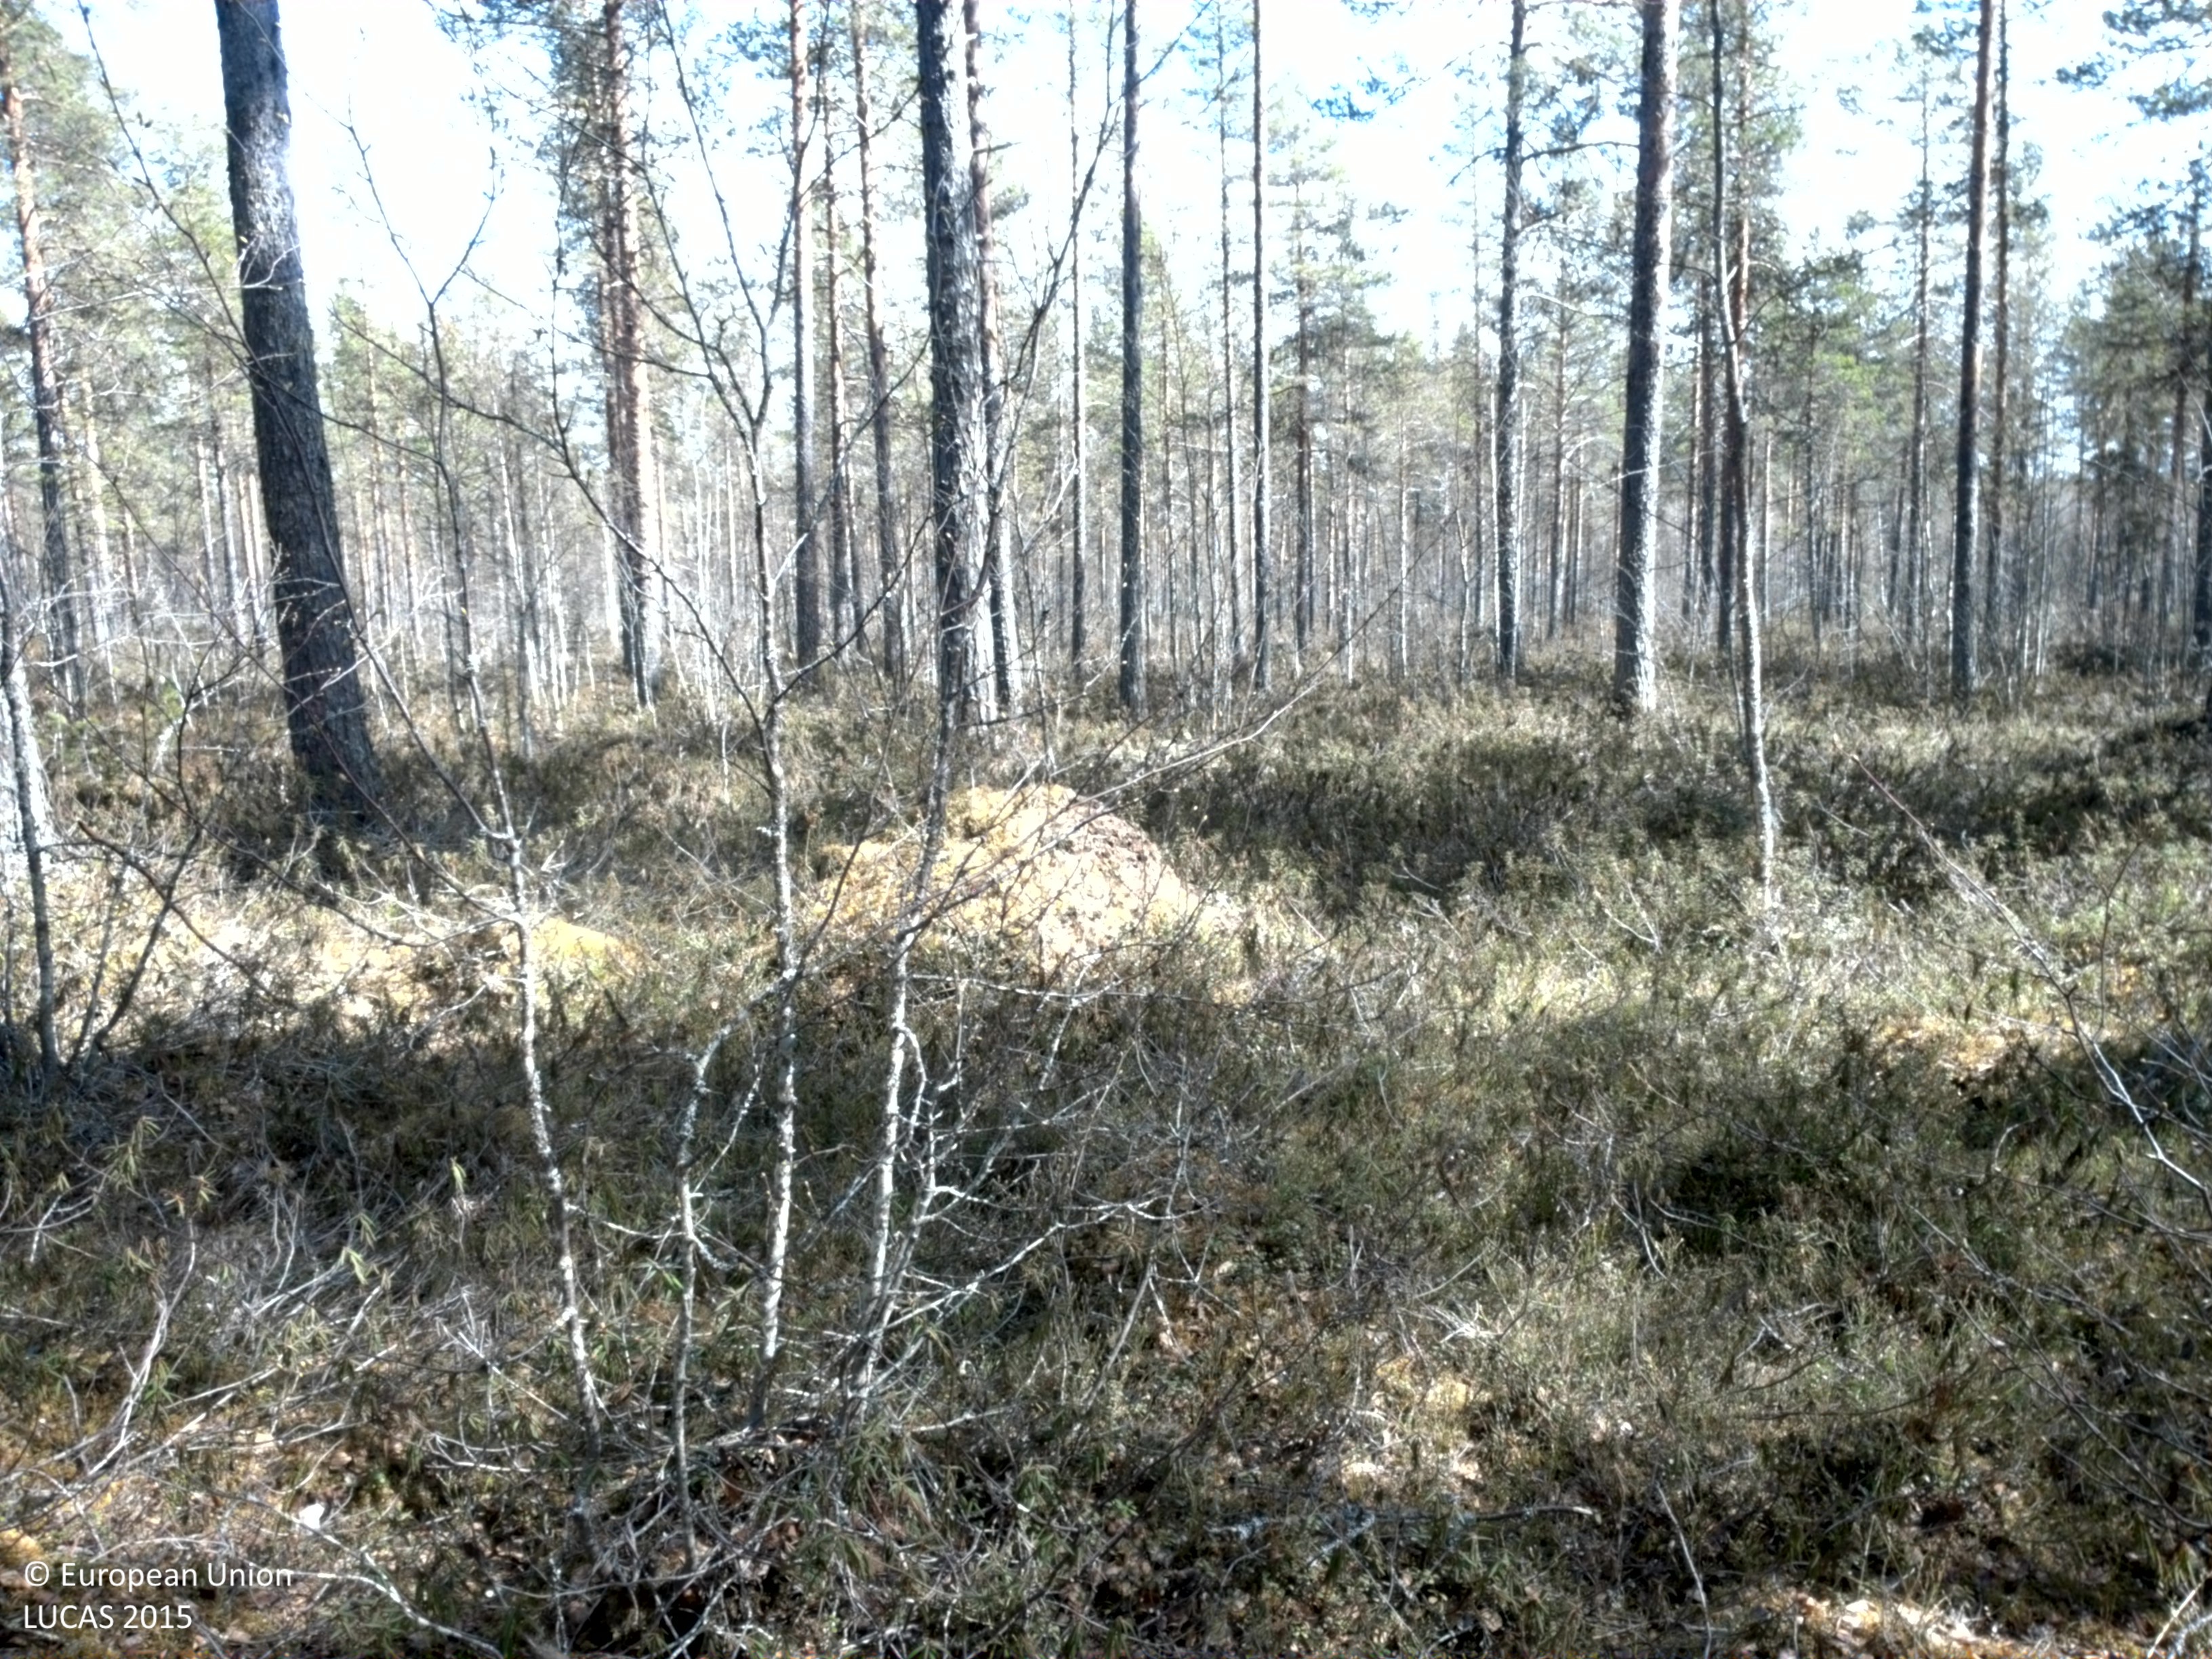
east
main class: Woodland
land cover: Pine dominated mixed woodland
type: boreal forest
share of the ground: 50 - 75 %
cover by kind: coniferous forest trees 45 %, shrubs 40 %, broadleaved forest trees 15 %
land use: Forestry
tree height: > 5 m
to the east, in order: Pine dominated mixed woodland; Ditches and canals; Groves; Tracks; Ditches and canals; Pine dominated mixed woodland
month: May
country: SE
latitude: 66.3005
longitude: 23.5207
